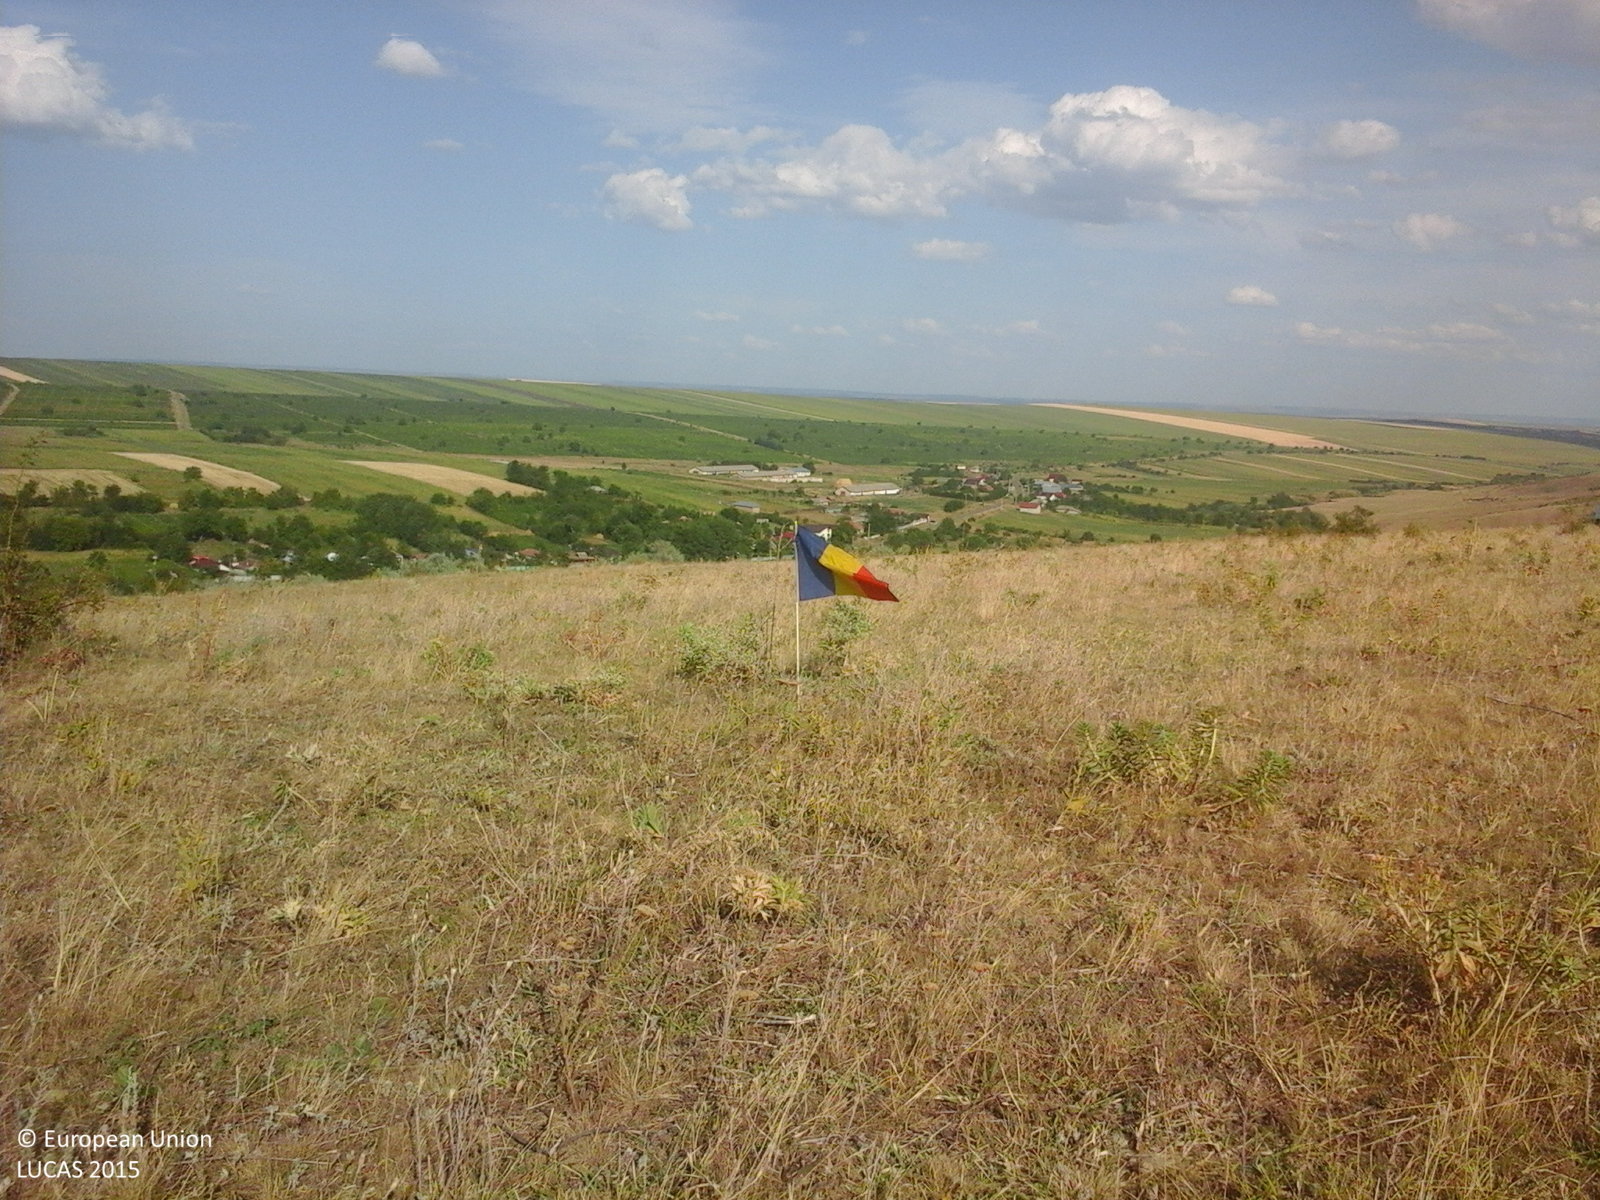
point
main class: Grassland
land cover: Spontaneously vegetated surfaces
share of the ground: > 75 %
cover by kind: herbaceous plants 100 %
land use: Fallow land
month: August
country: RO
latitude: 46.2789
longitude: 27.9144
